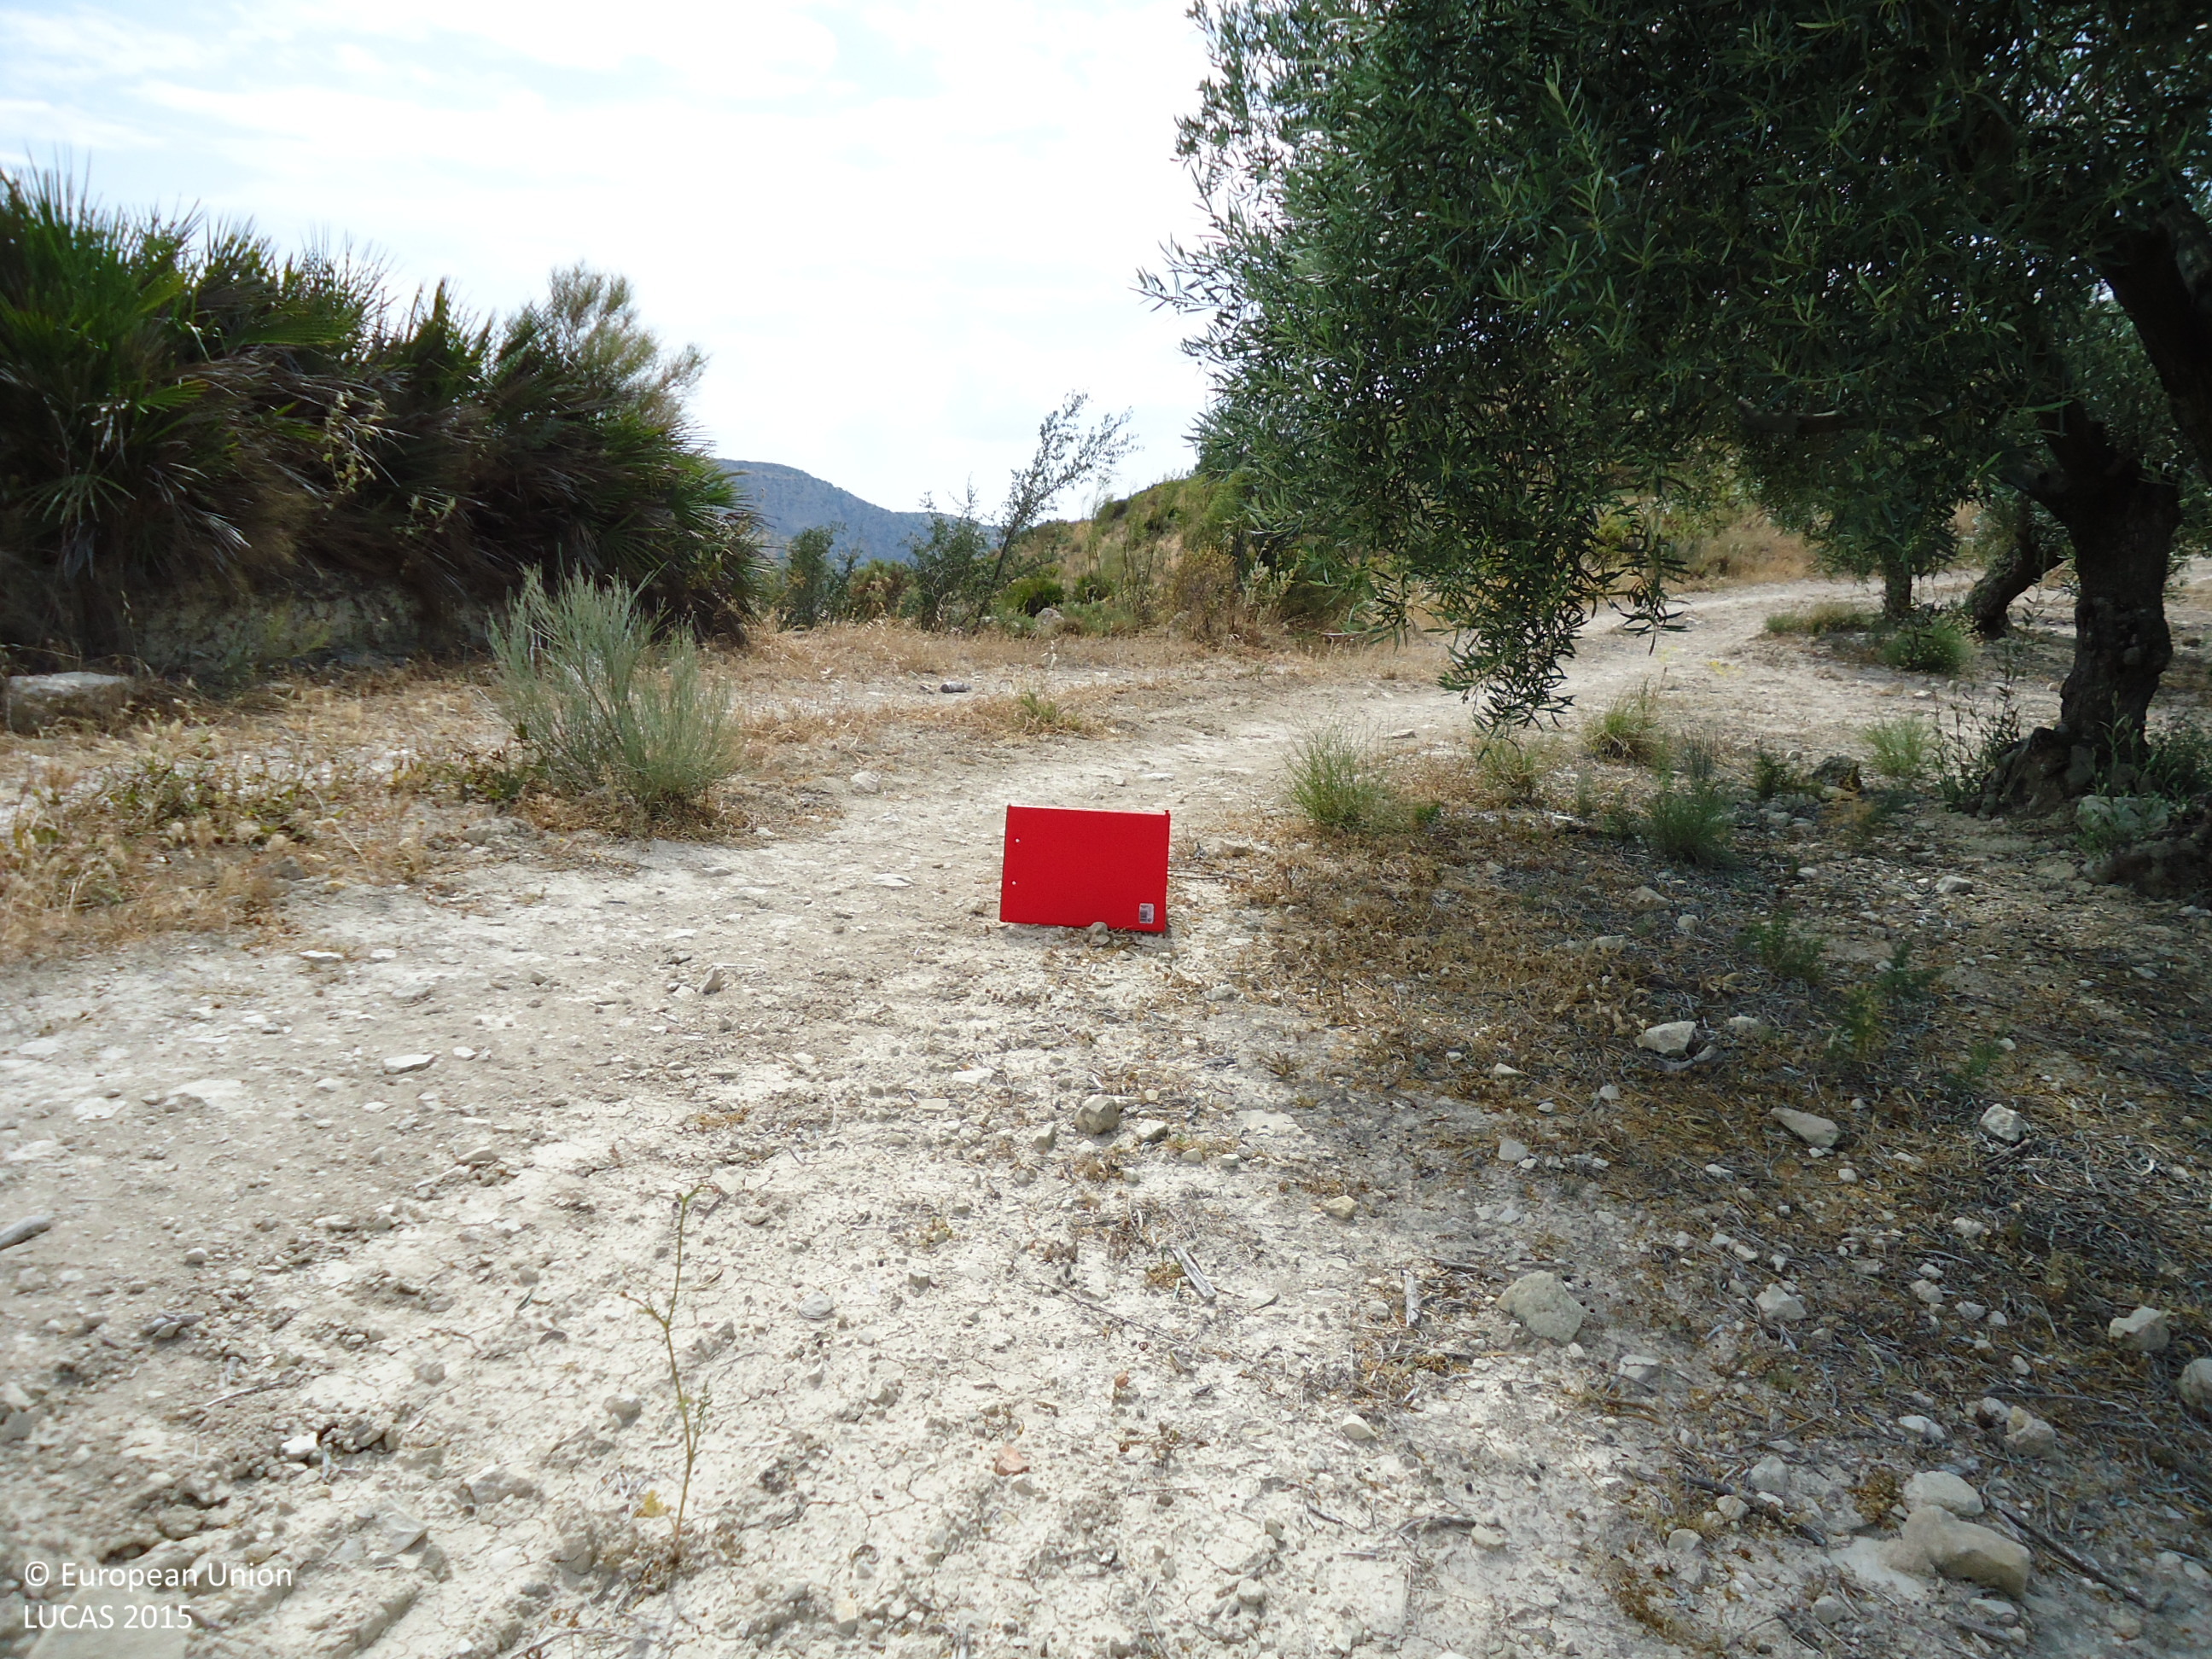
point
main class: Cropland
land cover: Olive groves
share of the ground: 25 - 50 %
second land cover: Other bare soil
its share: > 75 %
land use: Agriculture (excluding fallow land and kitchen gardens)
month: June
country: ES
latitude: 36.9845
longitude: -4.8178
